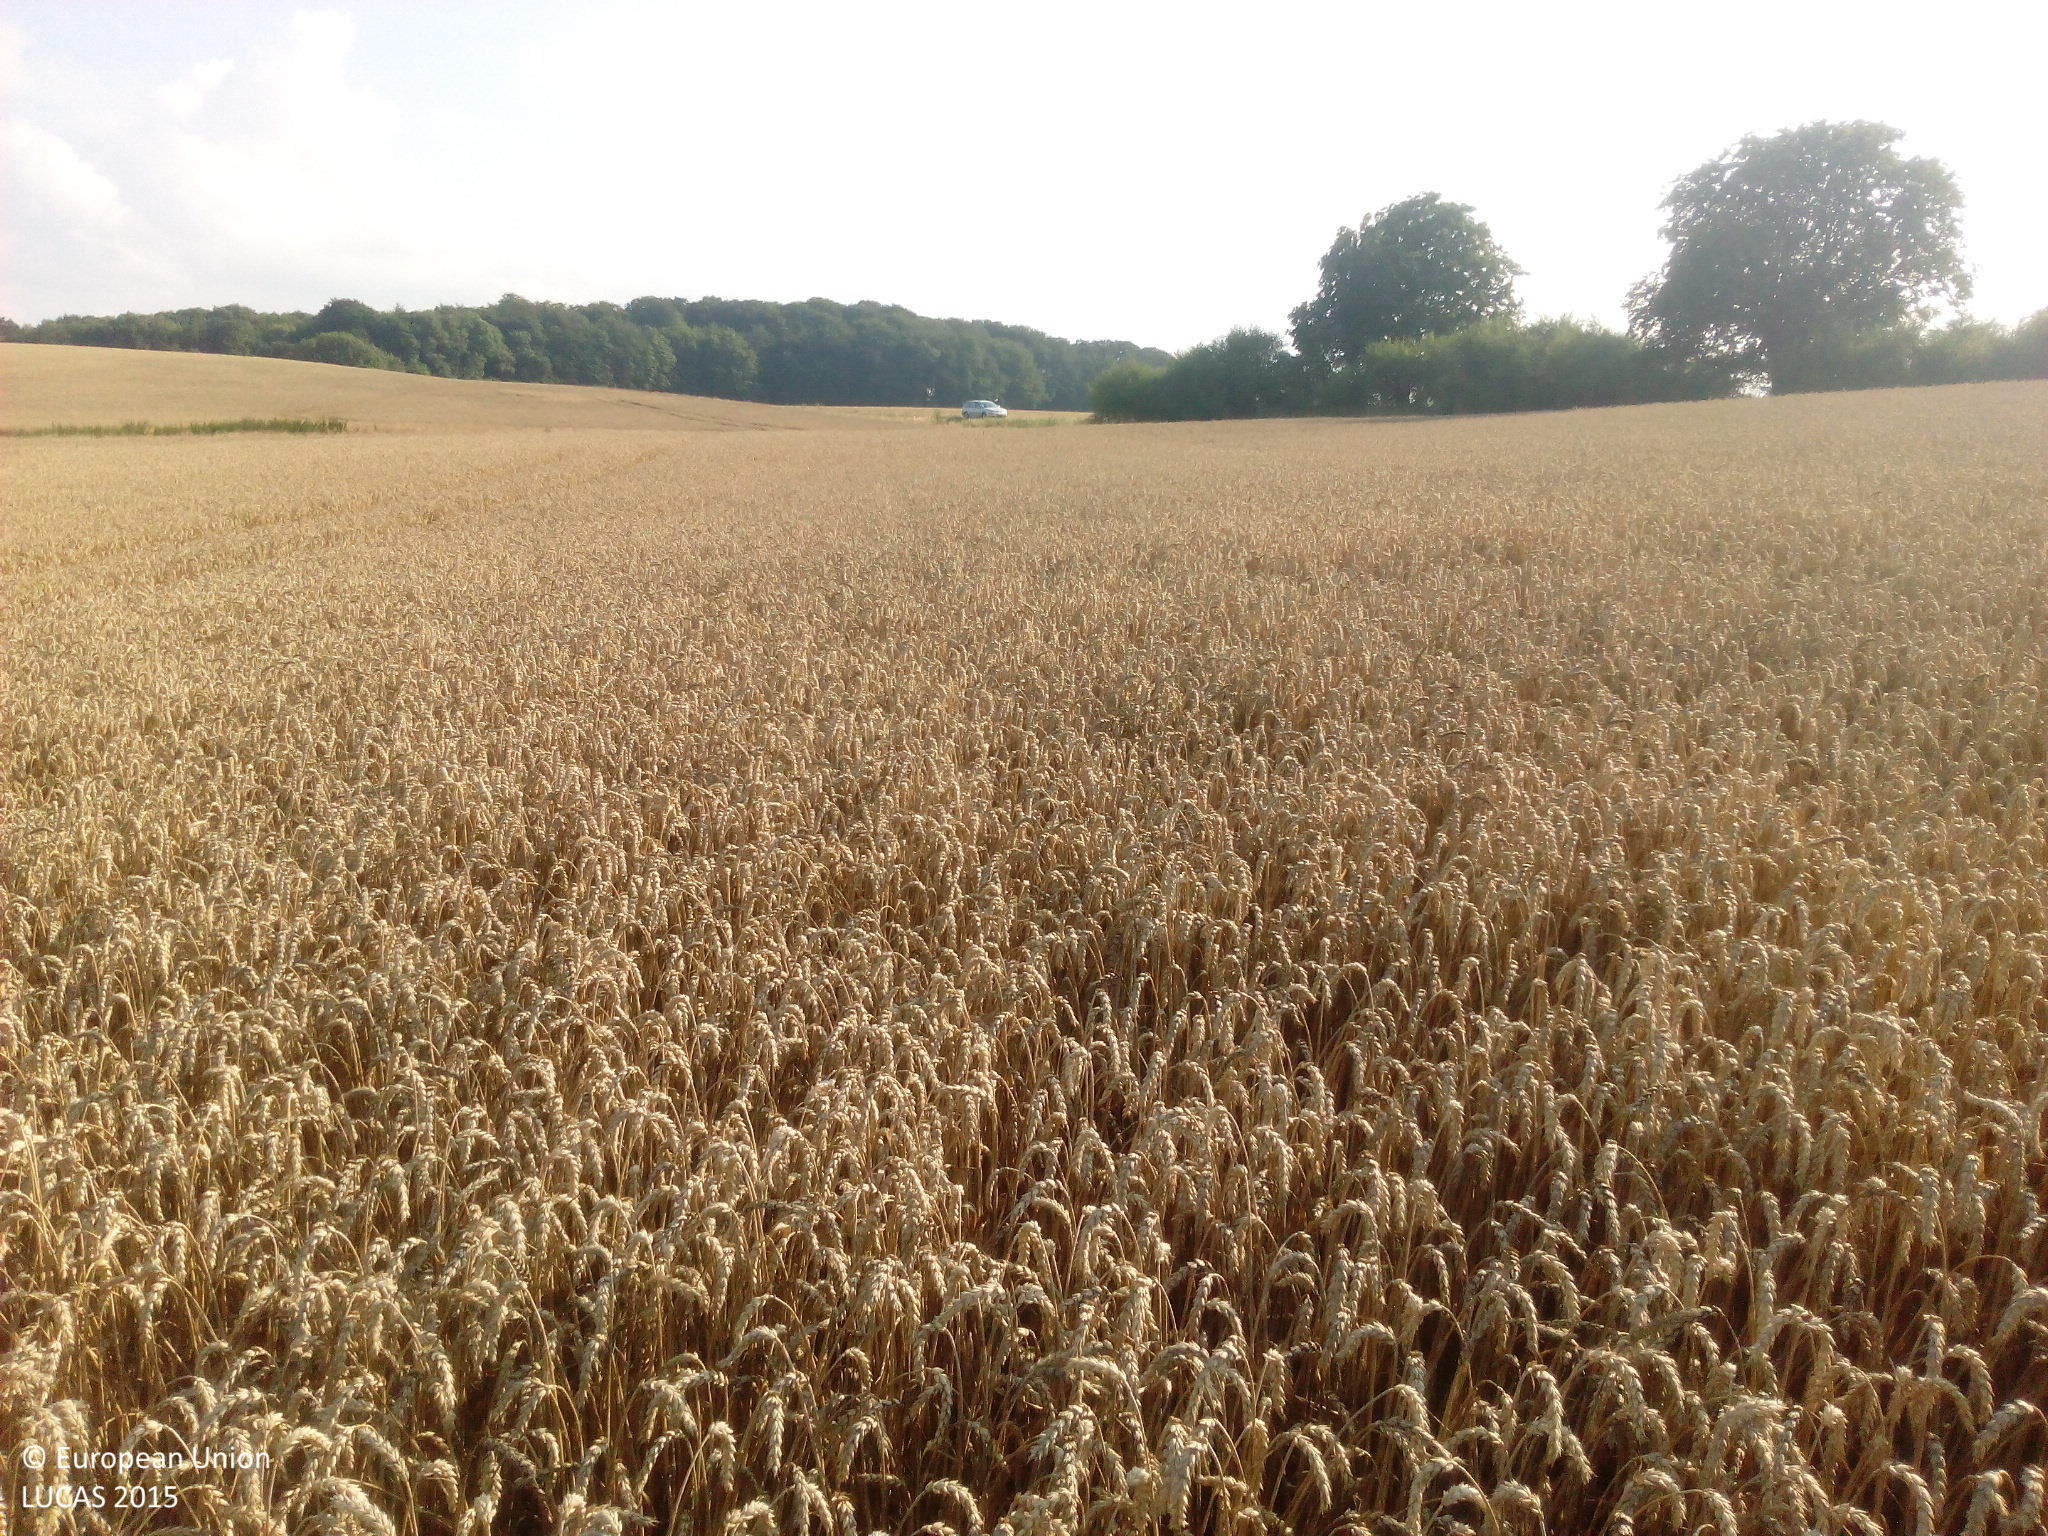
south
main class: Cropland
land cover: Common wheat
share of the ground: > 75 %
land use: Agriculture (excluding fallow land and kitchen gardens)
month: August
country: DE
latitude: 53.7678
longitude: 12.6846
